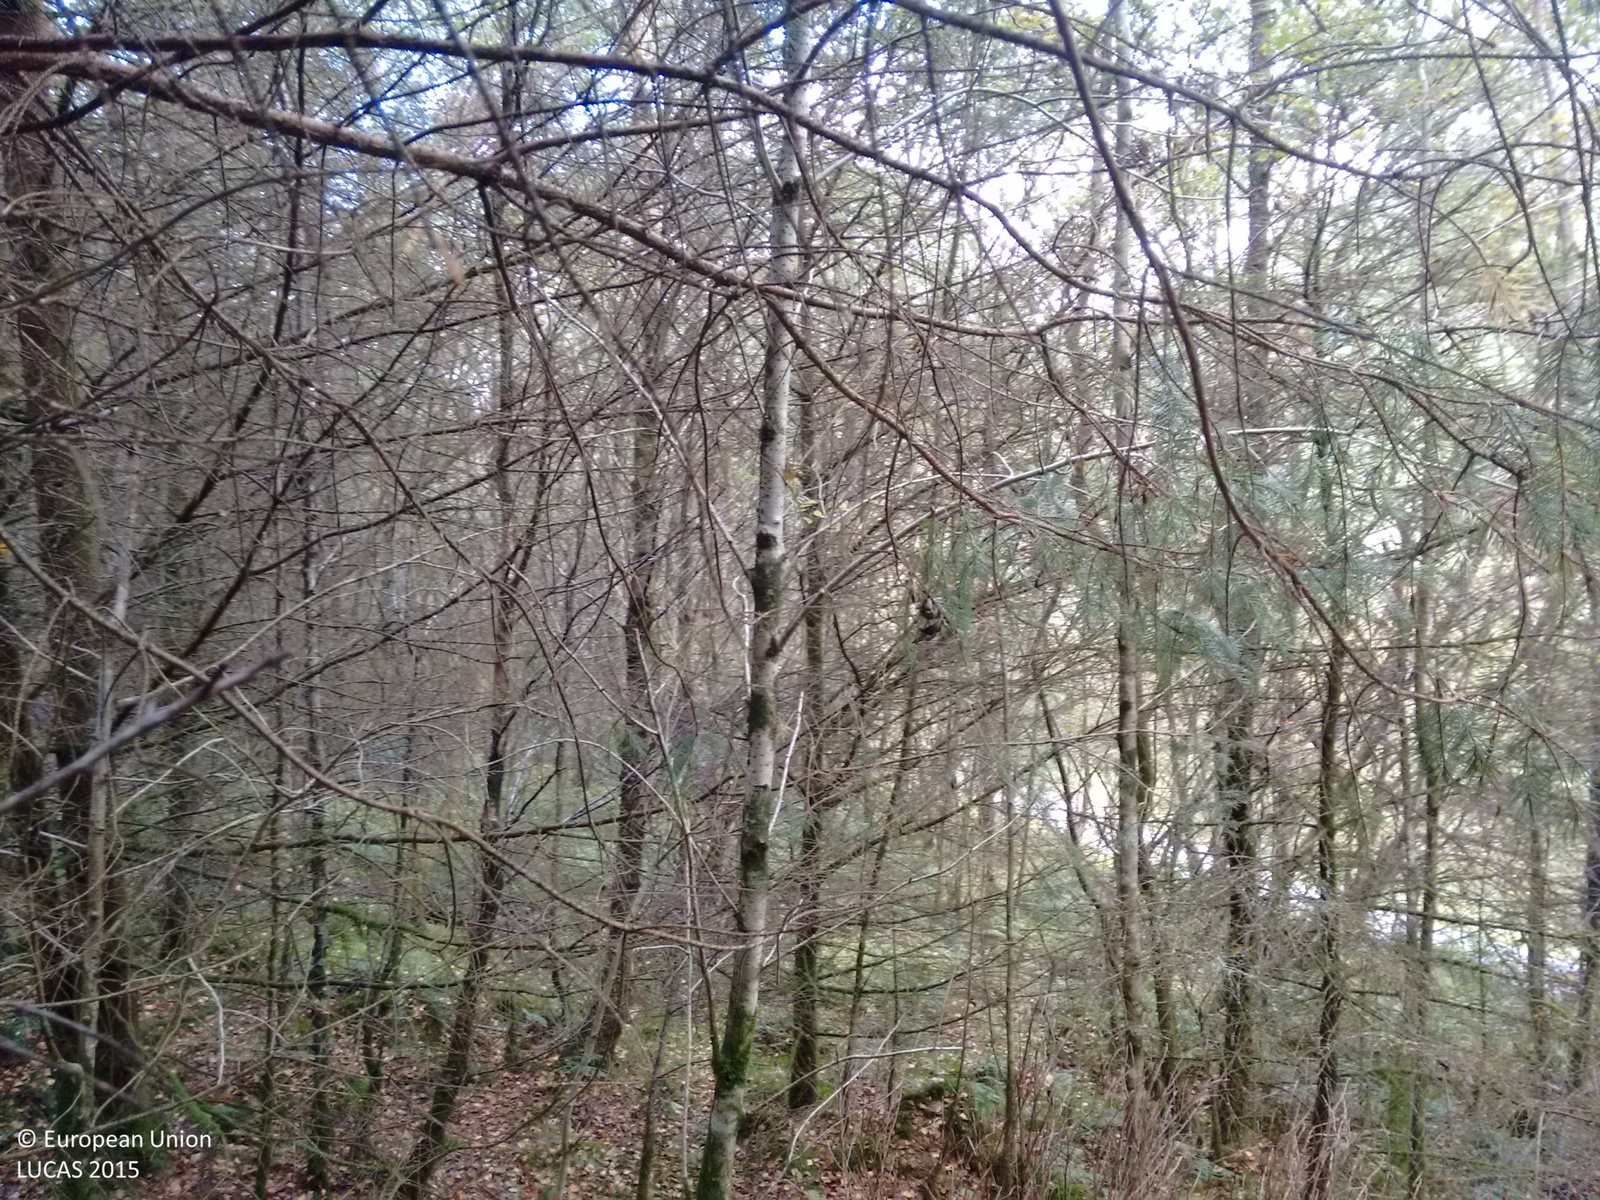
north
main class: Woodland
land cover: Pine dominated coniferous woodland
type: exotic forest
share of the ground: > 75 %
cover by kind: coniferous forest trees 100 %
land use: Forestry
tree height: > 5 m
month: October
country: GB
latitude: 52.5217
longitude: -3.9020
